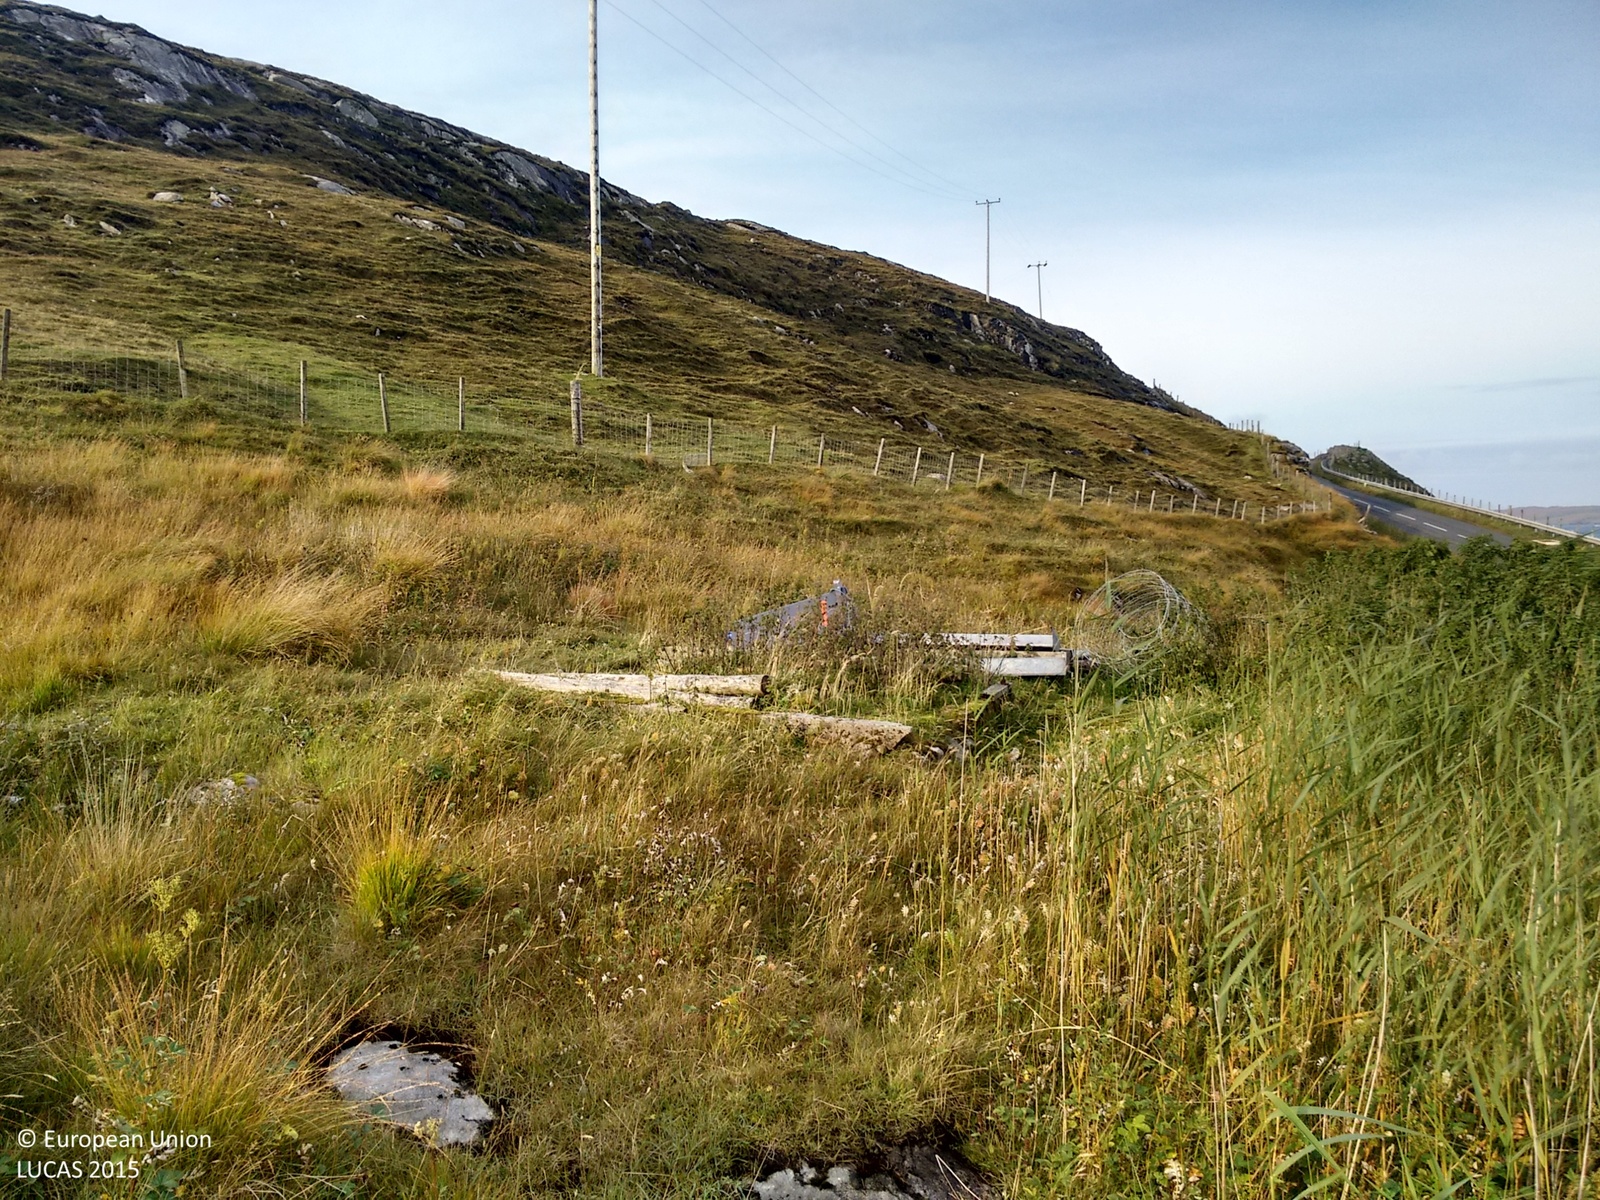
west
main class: Grassland
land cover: Grassland without tree/shrub cover
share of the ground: > 75 %
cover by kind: herbaceous plants 95 %
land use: Semi-natural and natural areas not in use
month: October
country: GB
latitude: 57.8670
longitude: -6.9605
